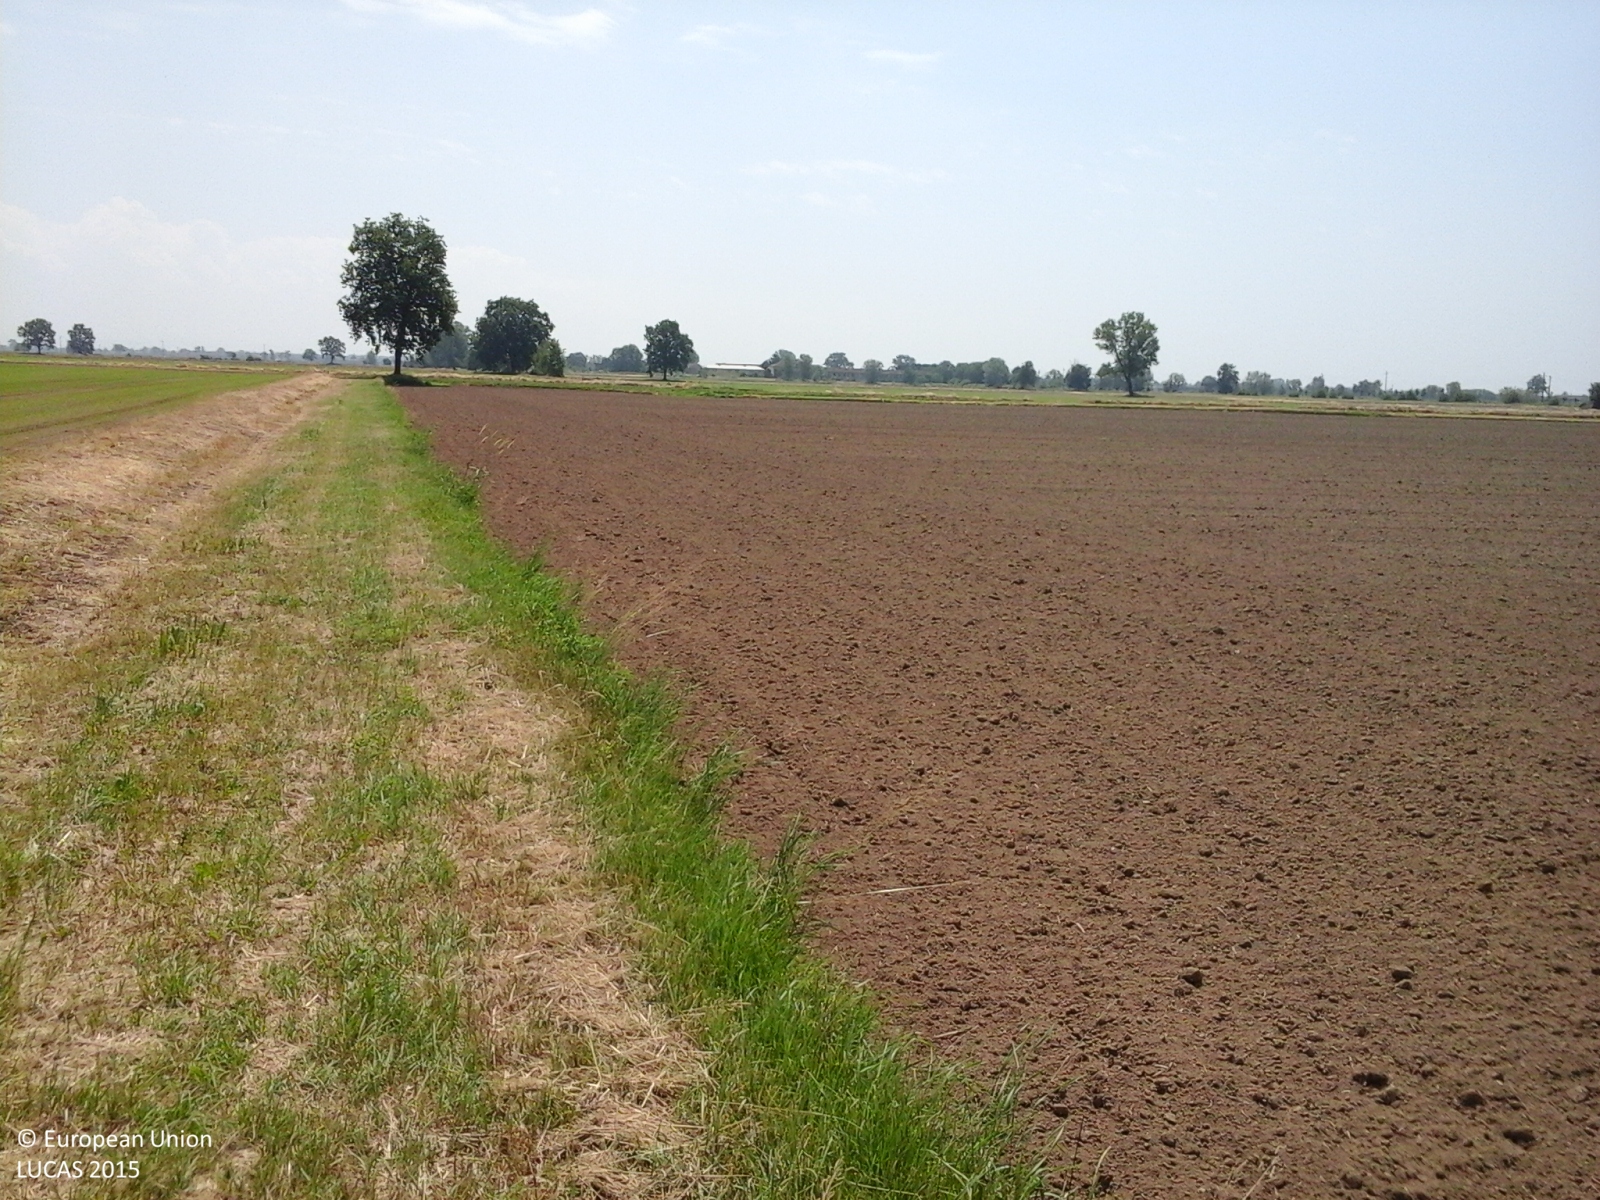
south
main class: Cropland
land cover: Rice
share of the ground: < 10 %
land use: Agriculture (excluding fallow land and kitchen gardens)
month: May
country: IT
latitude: 45.2482
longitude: 9.0970
